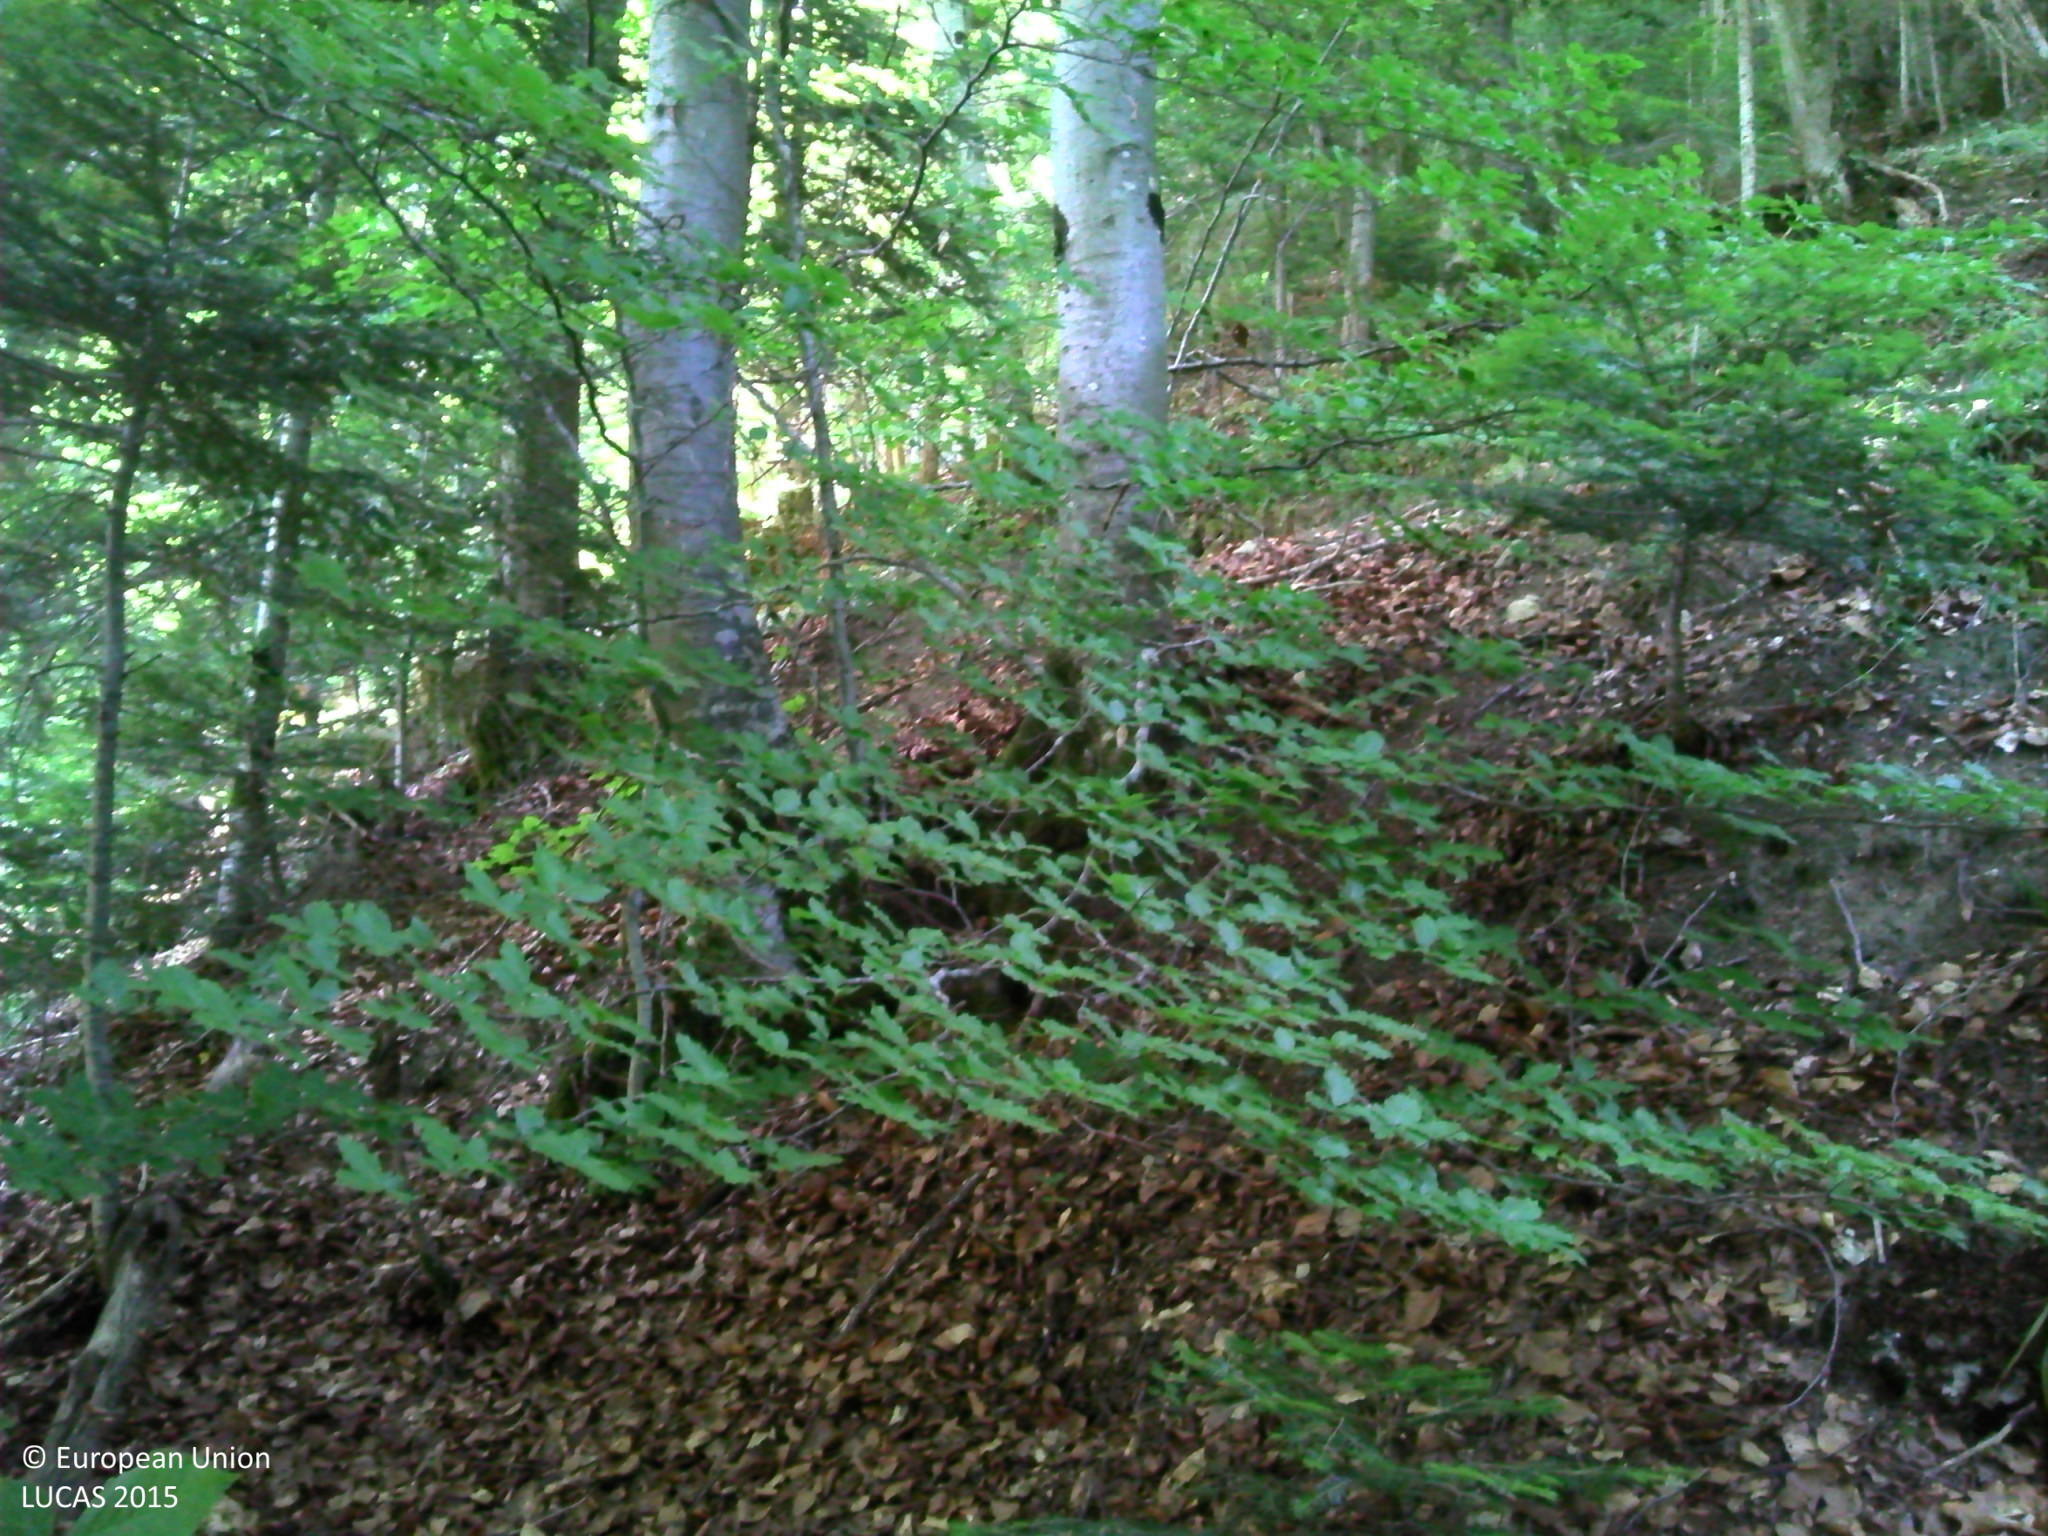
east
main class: Woodland
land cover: Other mixed woodland
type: mountainous beech forest
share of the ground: > 75 %
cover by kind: broadleaved forest trees 75 %, coniferous forest trees 25 %
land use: Forestry
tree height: > 5 m
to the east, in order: Other mixed woodland; Tracks; Other mixed woodland; Tracks; Other mixed woodland; Rivers and streams; Rock outcrops; Grassland without tree/shrub cover
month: July
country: FR
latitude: 42.8930
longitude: -0.1044
